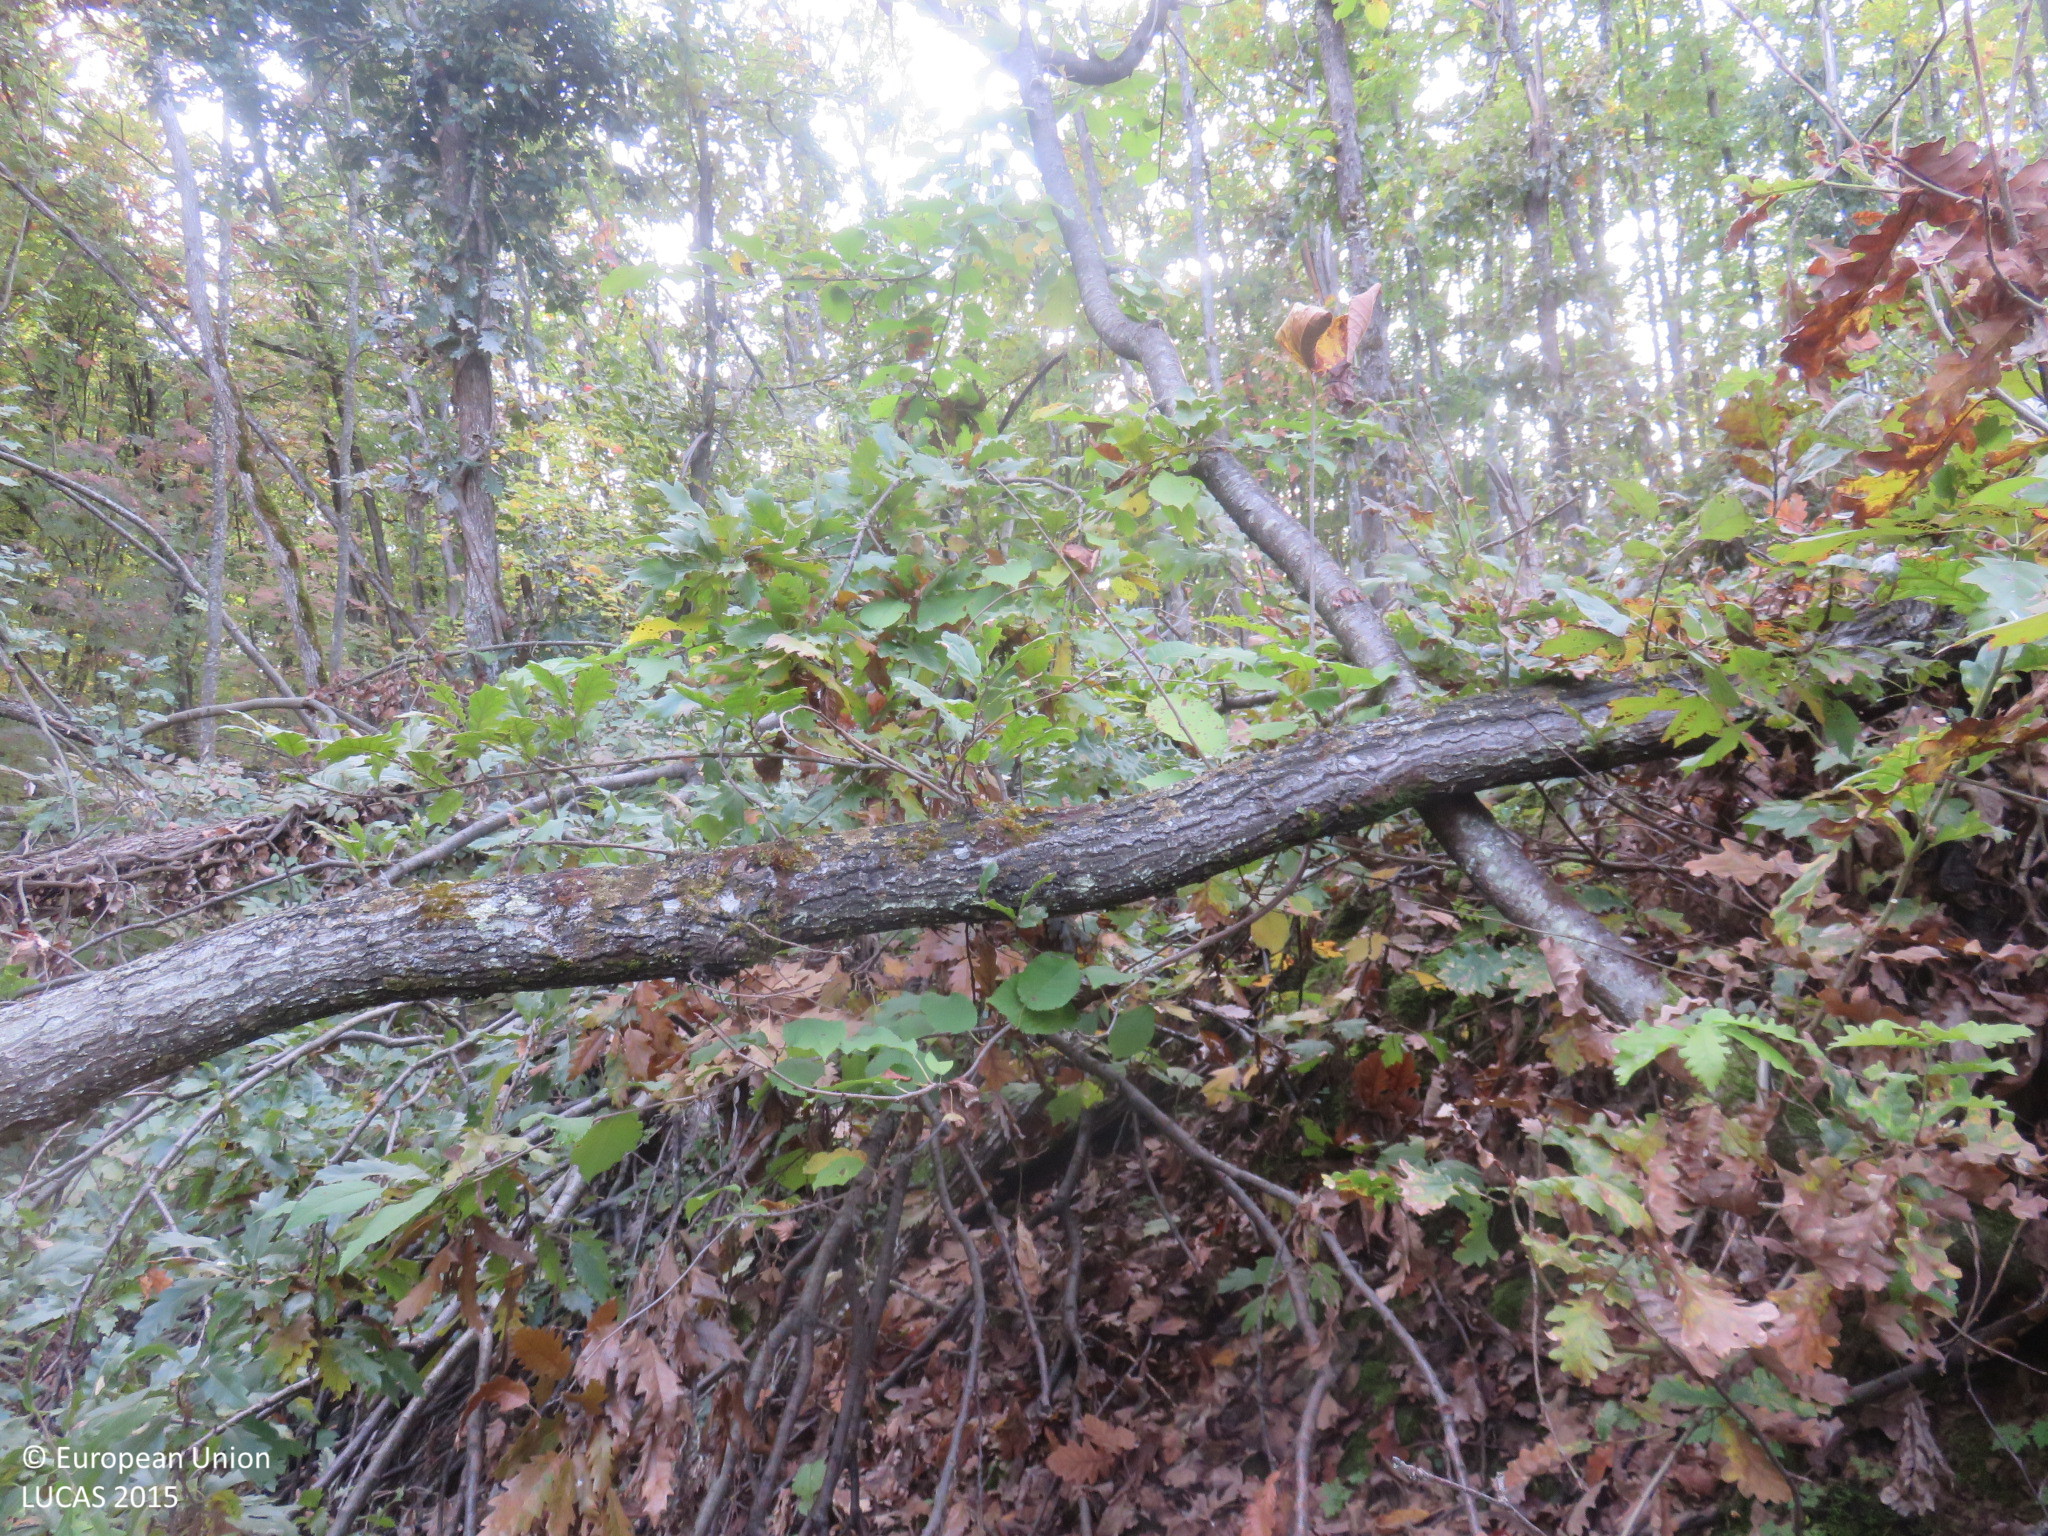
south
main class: Woodland
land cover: Broadleaved woodland
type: mesophytic deciduous forest
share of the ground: > 75 %
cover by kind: broadleaved forest trees 90 %, herbaceous plants 5 %, unconsolidated bare surface 5 %
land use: Forestry
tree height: < 5 m
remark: Clear cut
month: October
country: BG
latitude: 42.9231
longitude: 24.9995
